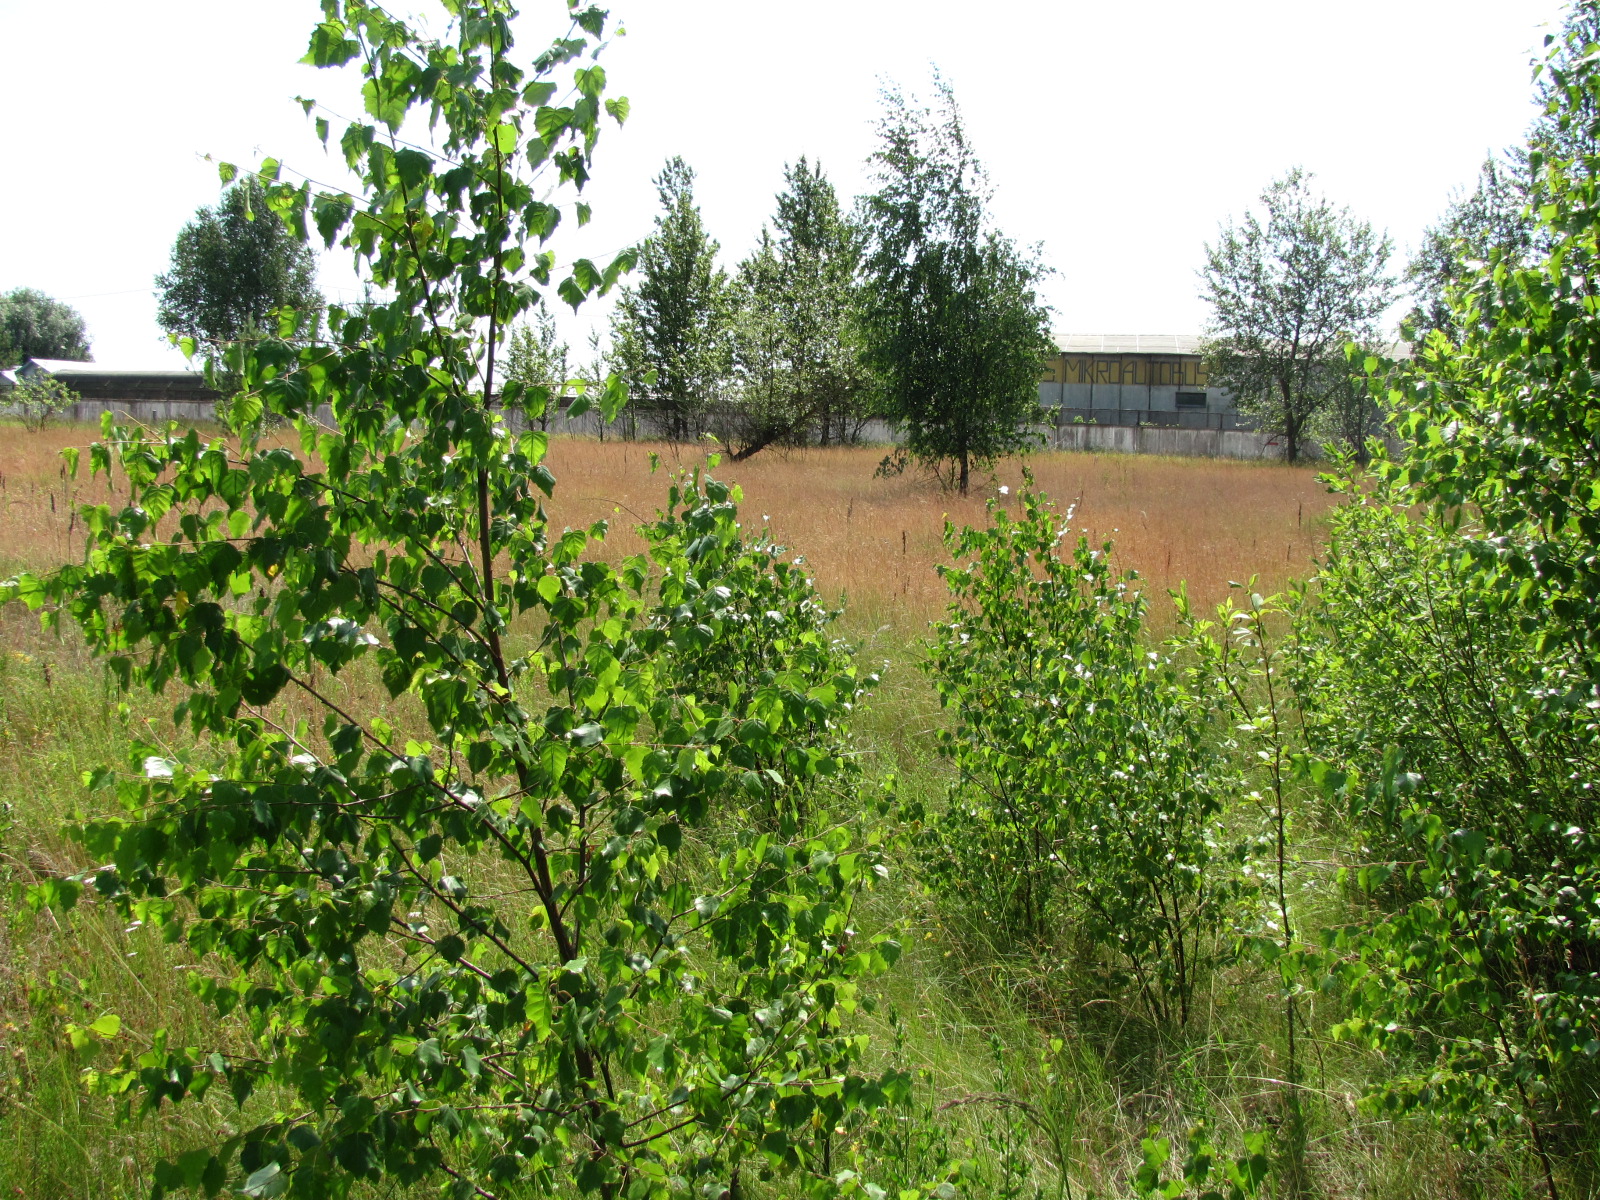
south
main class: Woodland
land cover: Broadleaved woodland
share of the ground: 50 - 75 %
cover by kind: broadleaved forest trees 60 %, herbaceous plants 40 %
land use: Amenities, museums, leisure
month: July
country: LV
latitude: 56.8903
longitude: 24.2208
